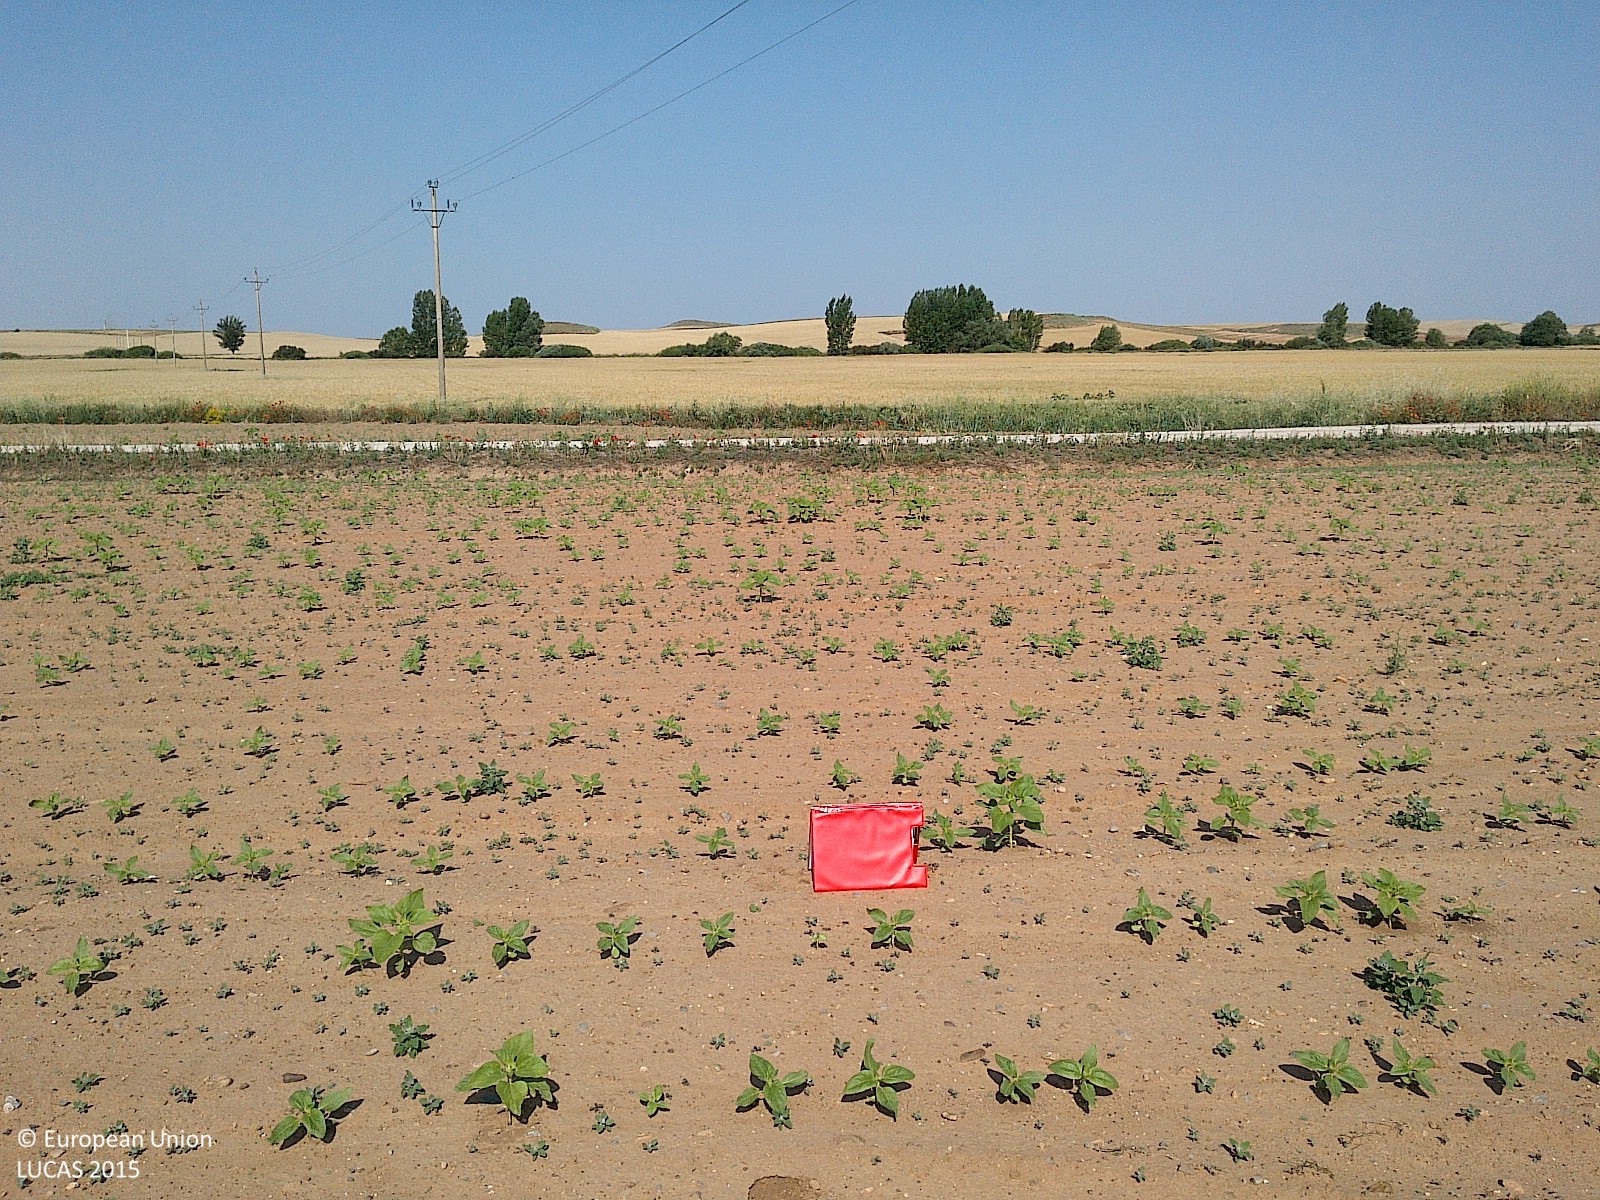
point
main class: Cropland
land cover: Sunflower
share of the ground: < 10 %
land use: Agriculture (excluding fallow land and kitchen gardens)
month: June
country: ES
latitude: 41.6139
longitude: -2.2626
